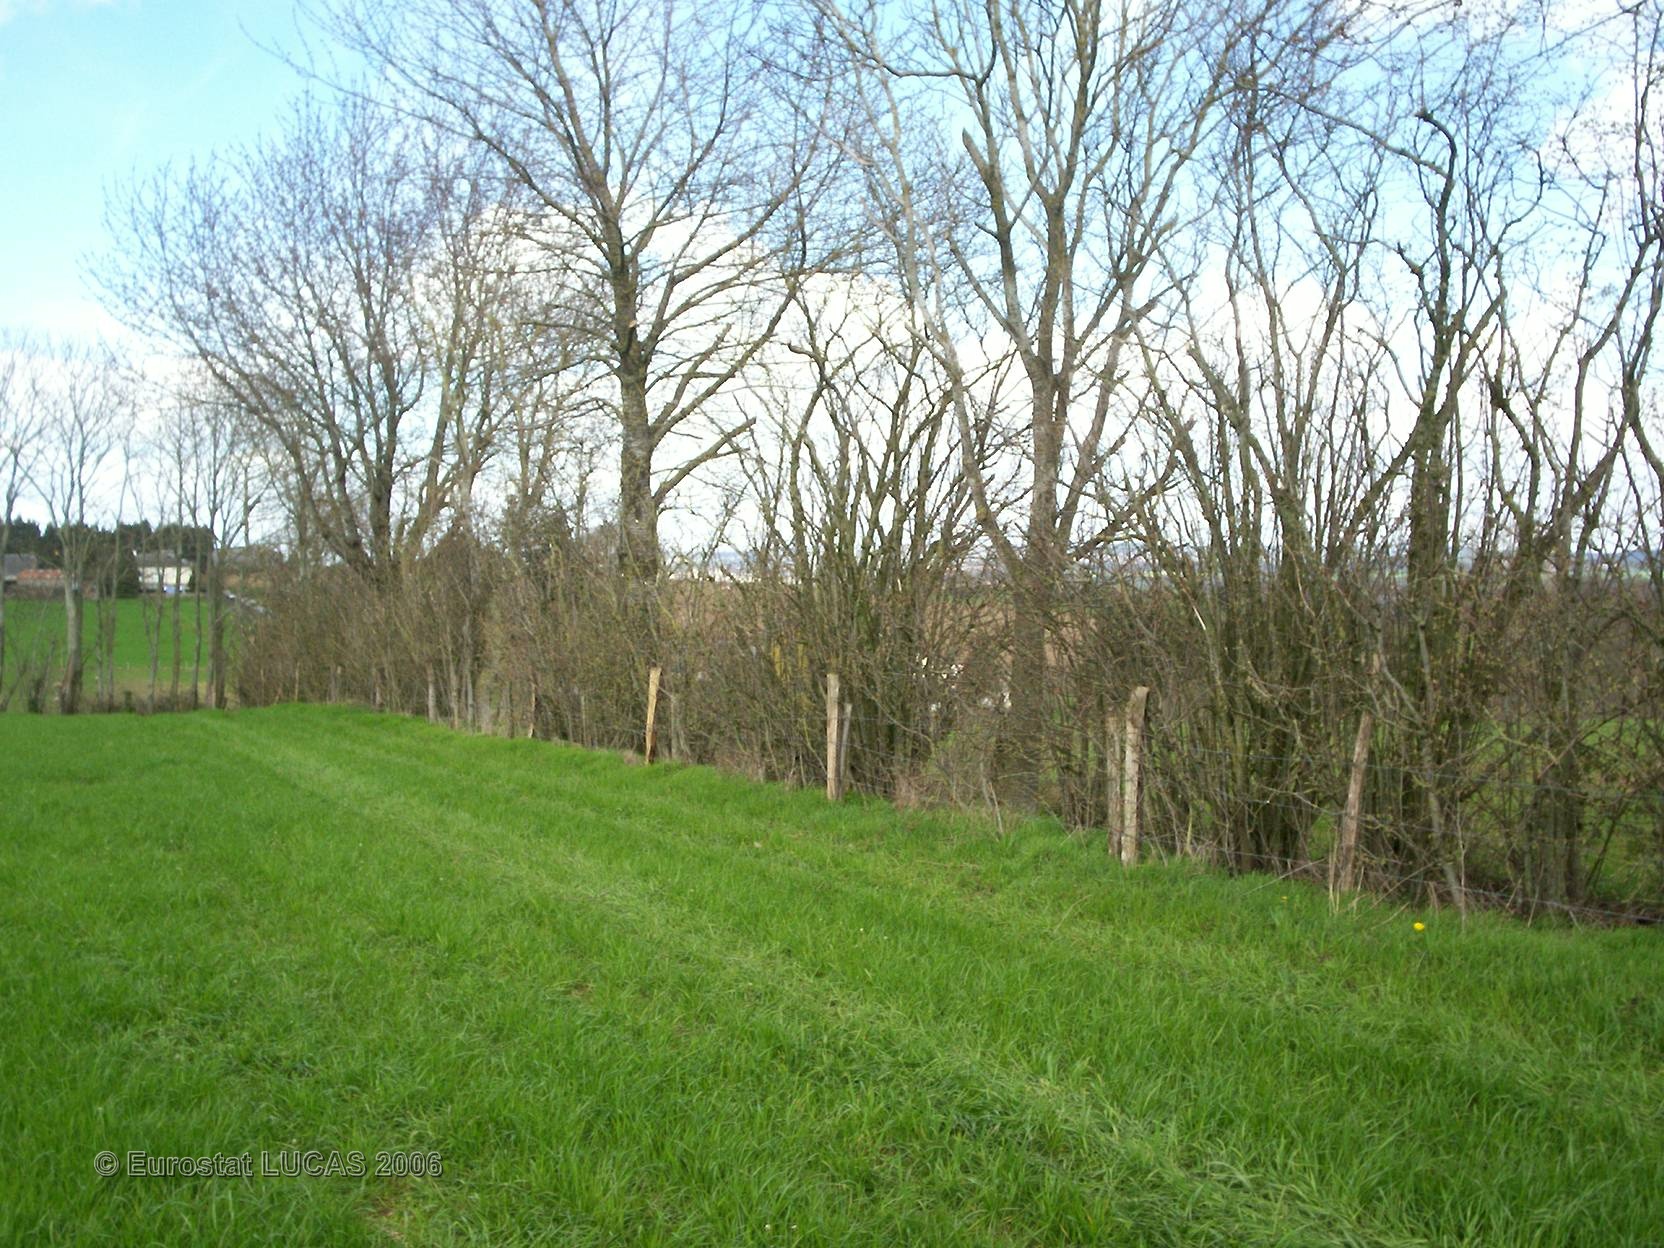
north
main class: Grassland
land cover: Grassland without tree/shrub cover
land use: Agriculture (excluding fallow land and kitchen gardens)
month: April
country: FR
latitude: 48.3054
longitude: -0.2647
